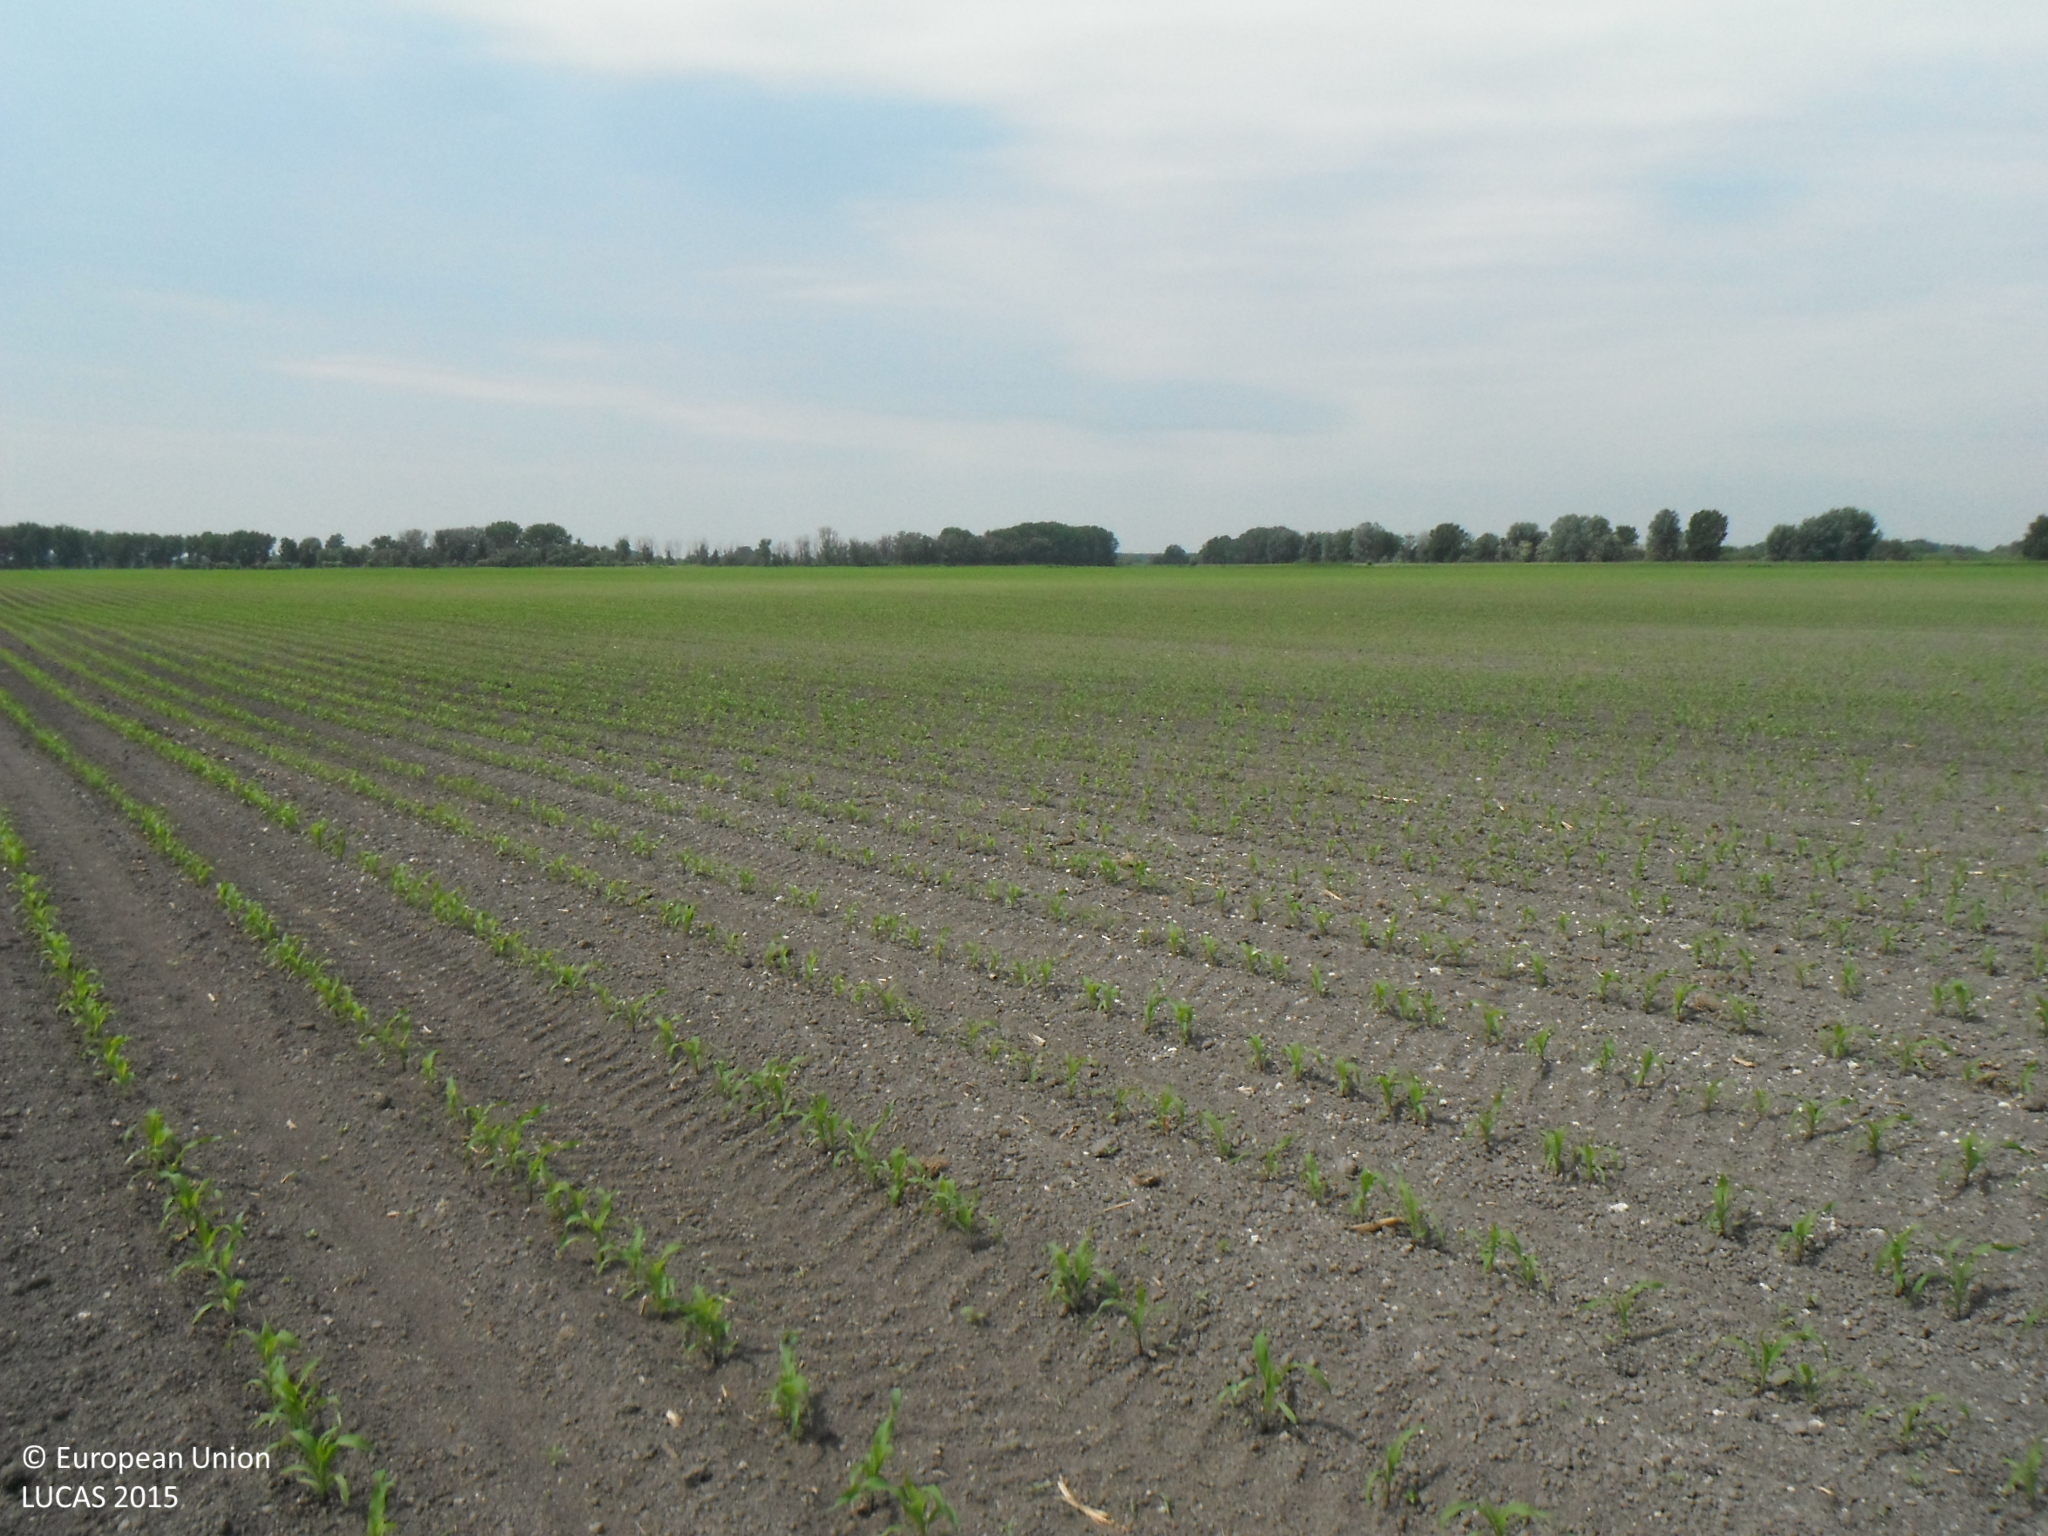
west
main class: Cropland
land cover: Maize
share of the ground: < 10 %
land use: Agriculture (excluding fallow land and kitchen gardens)
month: May
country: SK
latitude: 47.8978
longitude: 17.7285
